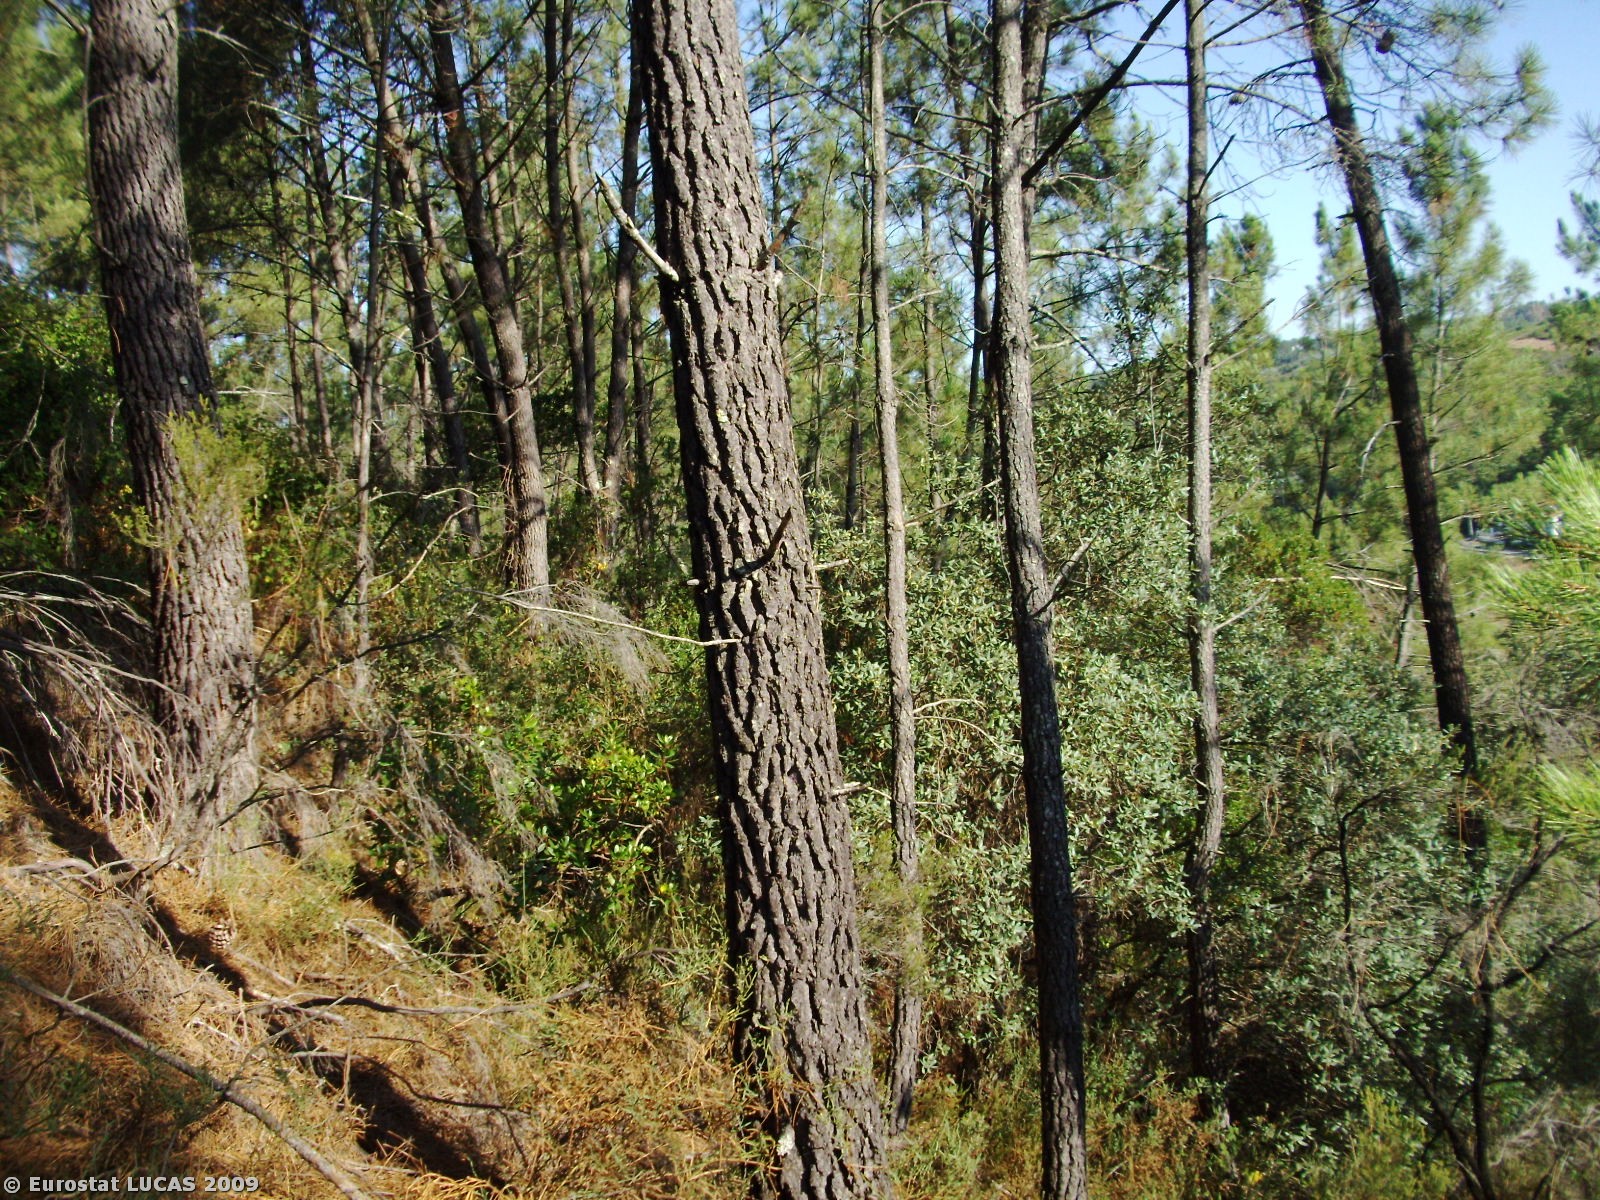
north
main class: Woodland
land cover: Coniferous woodland
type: coniferous forest of the mediterranean region
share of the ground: > 75 %
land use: Forestry
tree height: > 5 m
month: August
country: PT
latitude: 39.8039
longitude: -8.1132
